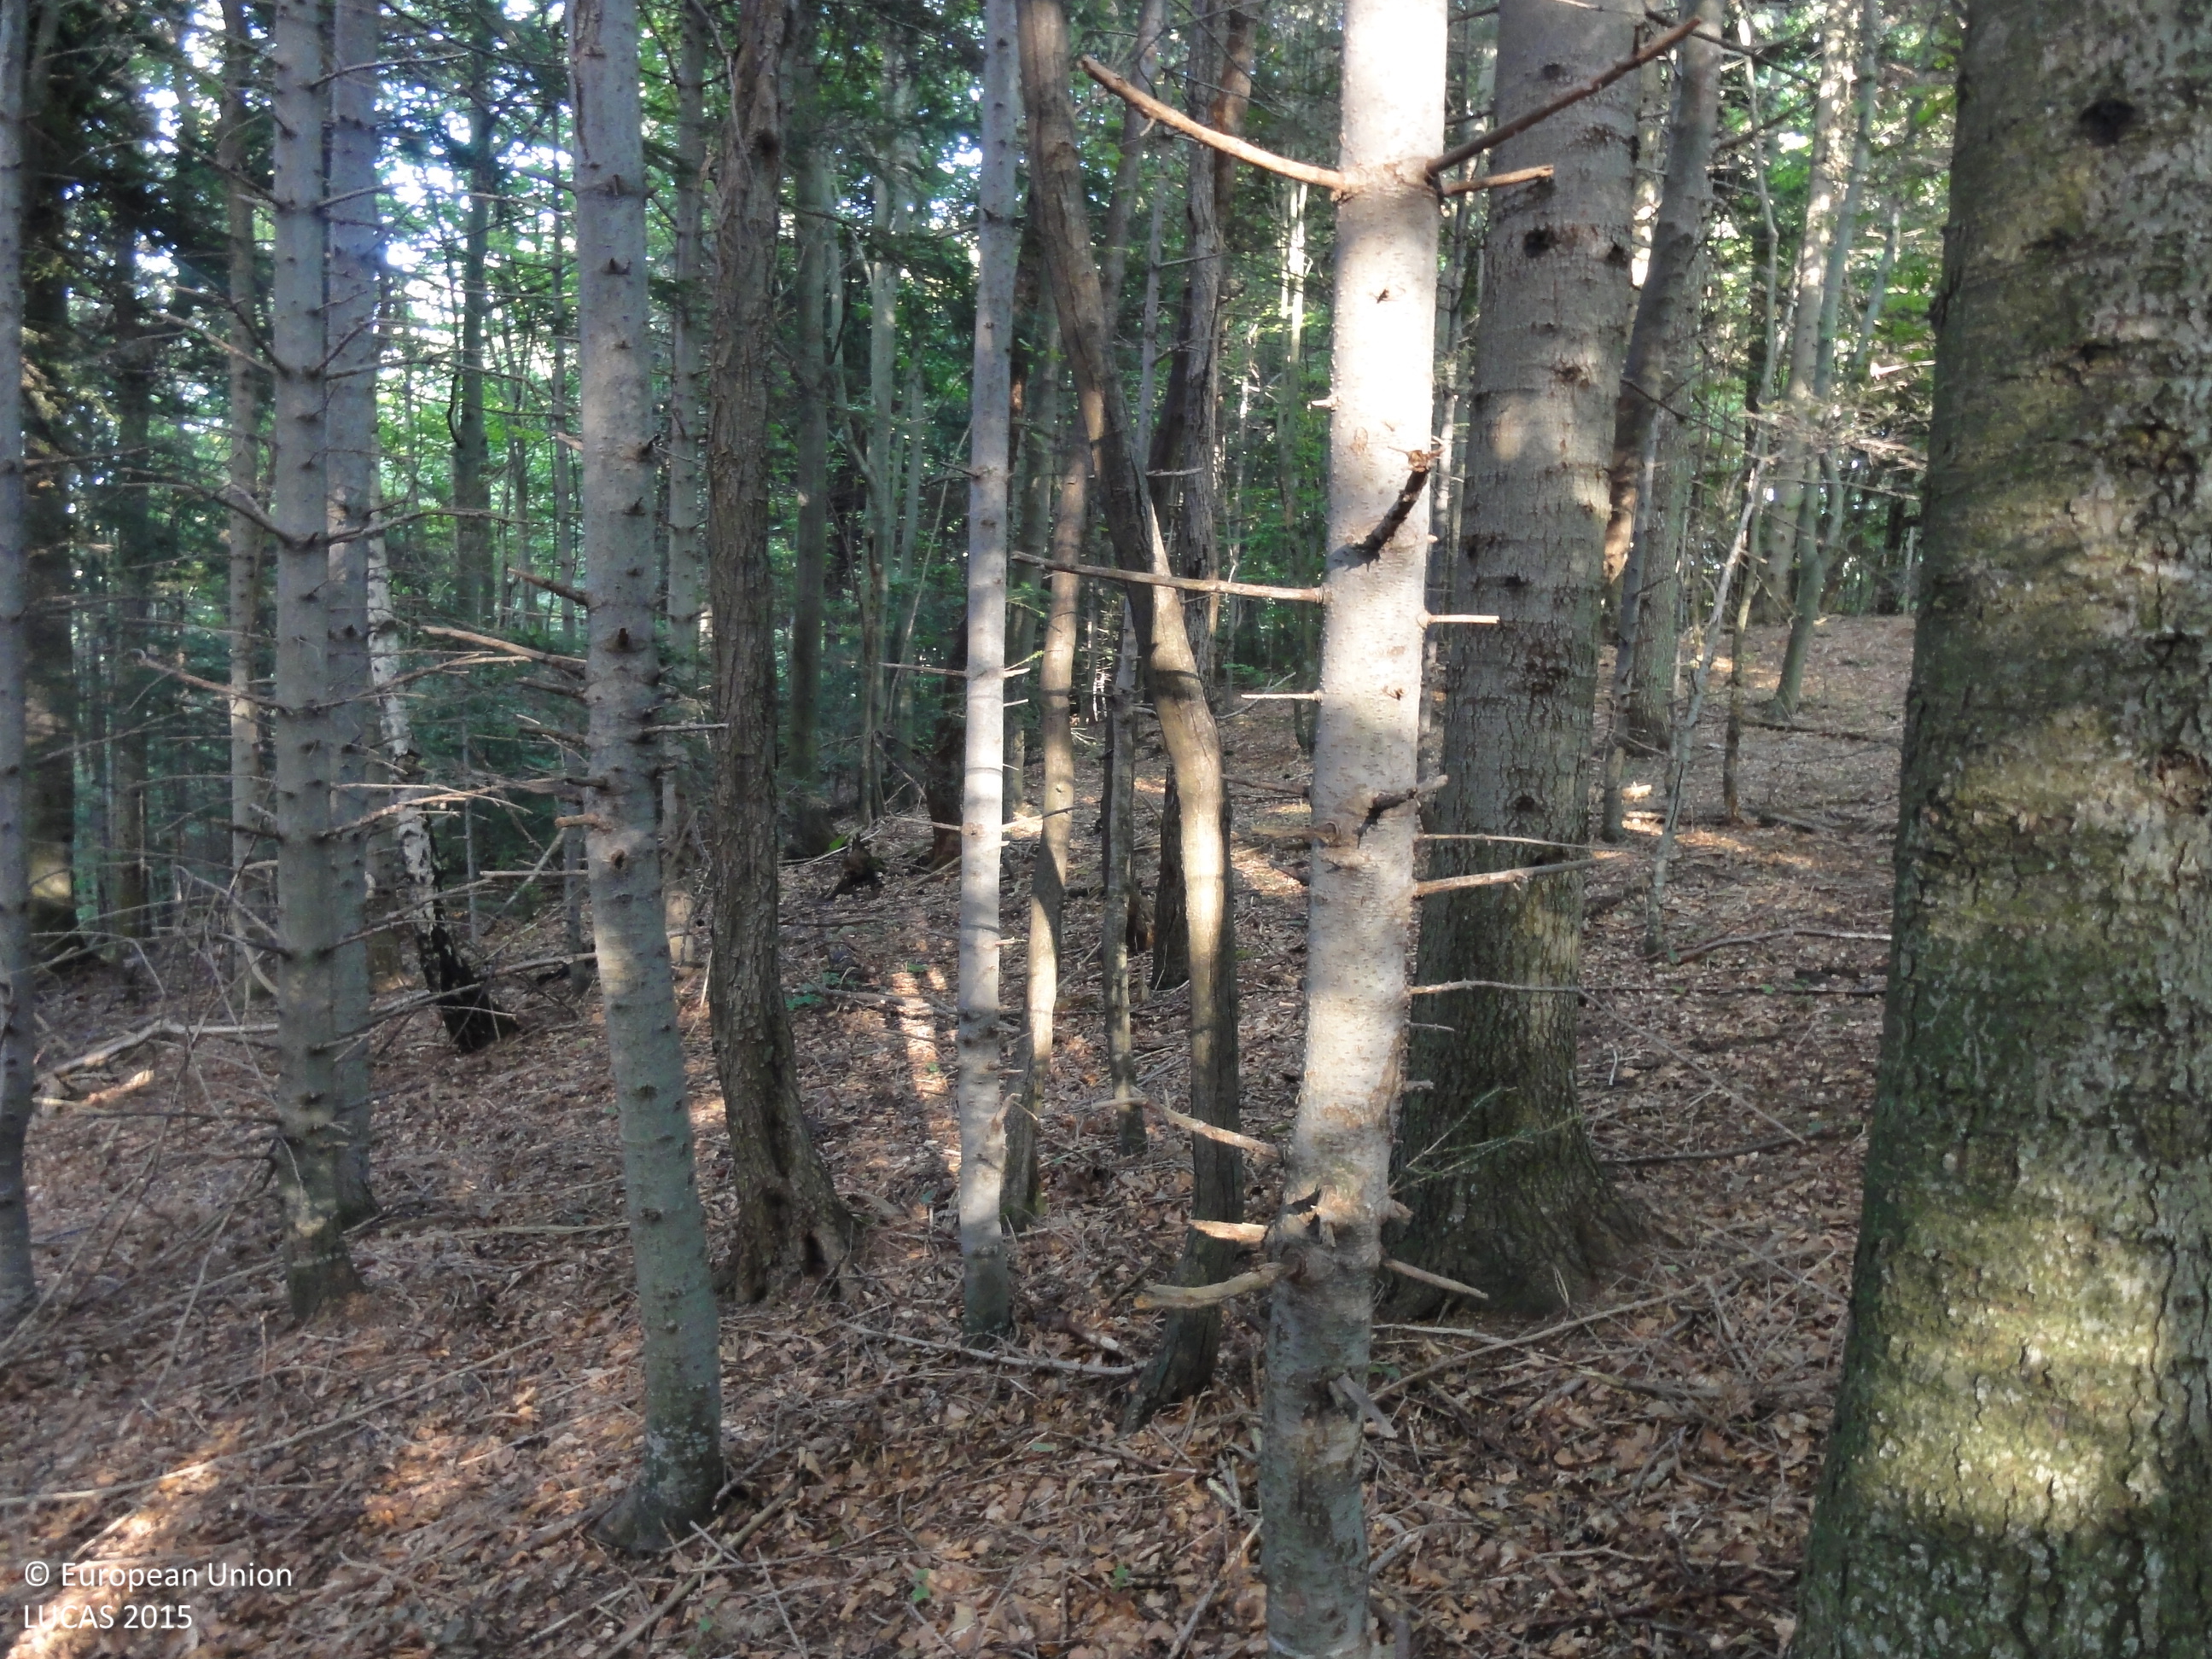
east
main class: Woodland
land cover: Spruce dominated mixed woodland
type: mountainous beech forest
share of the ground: > 75 %
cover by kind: coniferous forest trees 70 %, broadleaved forest trees 30 %
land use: Forestry
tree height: > 5 m
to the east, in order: Spruce dominated mixed woodland; Tracks; Spruce dominated mixed woodland; Tracks; Spruce dominated mixed woodland
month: August
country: SI
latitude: 46.0657
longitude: 15.4919
